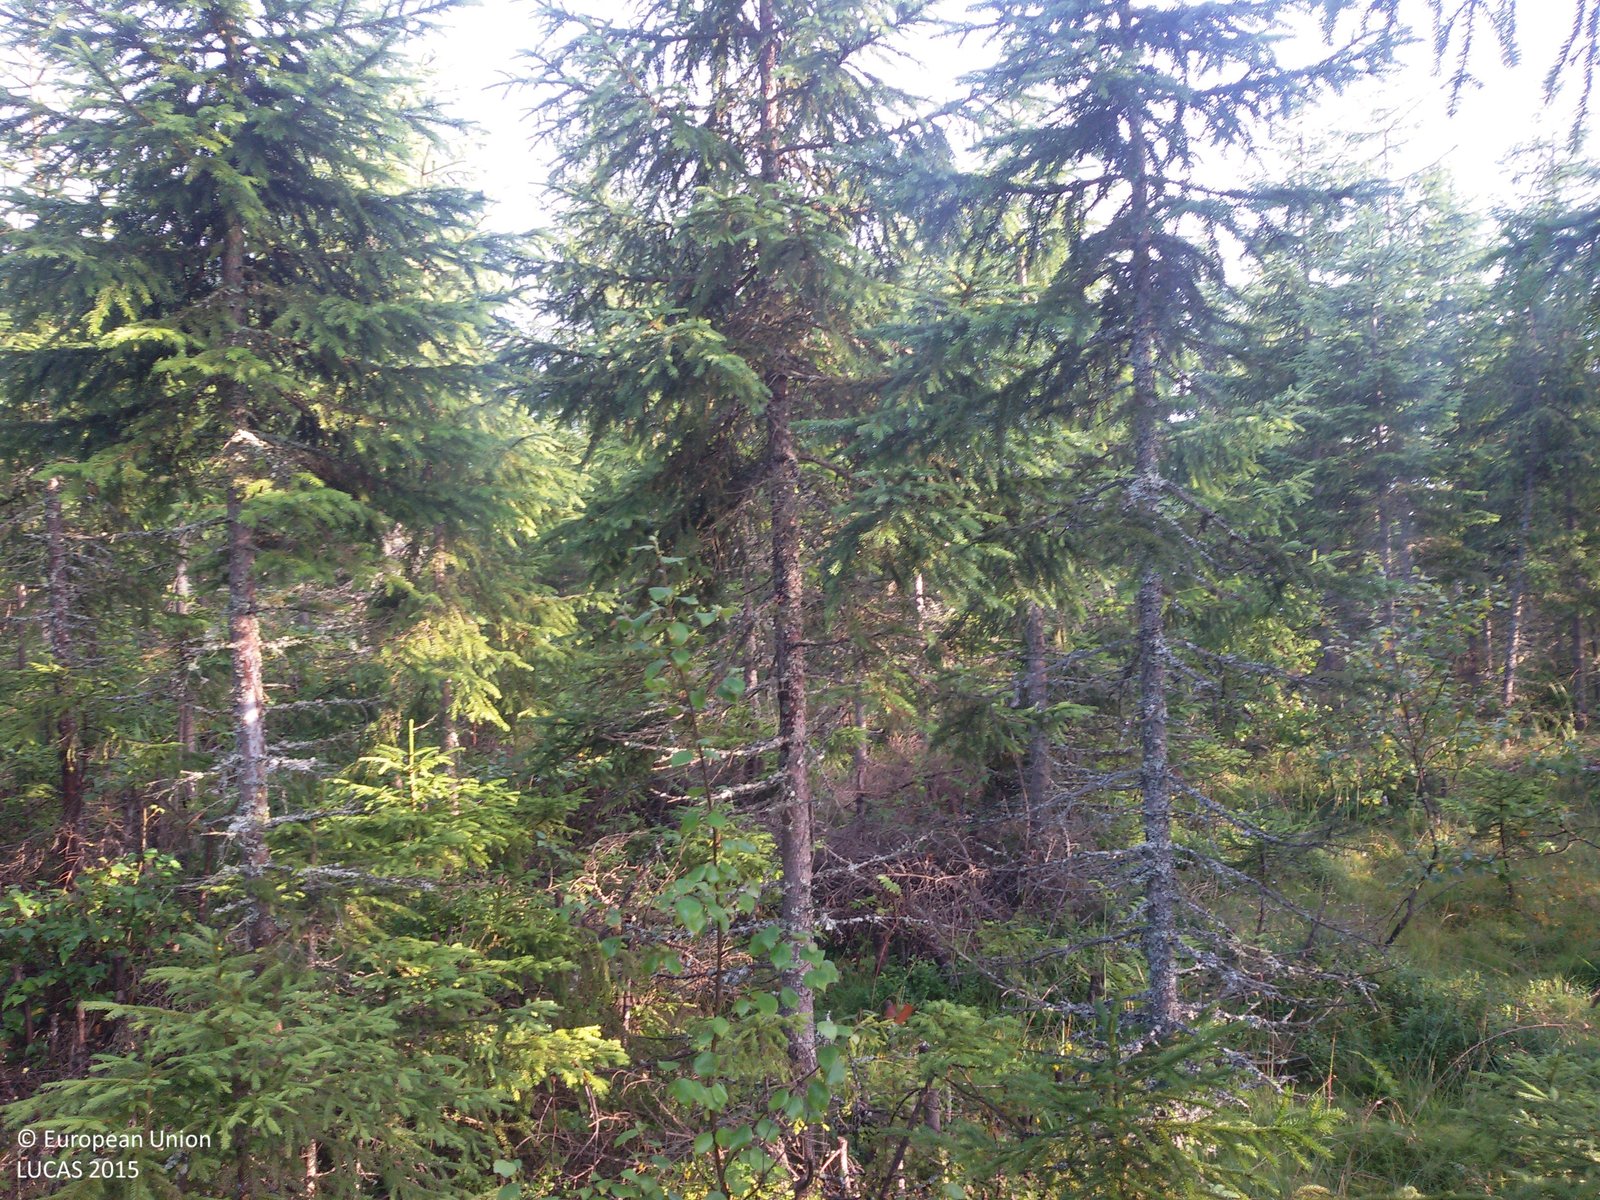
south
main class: Woodland
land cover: Spruce dominated coniferous woodland
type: boreal forest
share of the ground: 50 - 75 %
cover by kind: coniferous forest trees 50 %, herbaceous plants 30 %, broadleaved forest trees 10 %, lichens and mosses 10 %
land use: Forestry
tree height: < 5 m
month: August
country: SE
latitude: 60.8024
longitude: 16.6215
